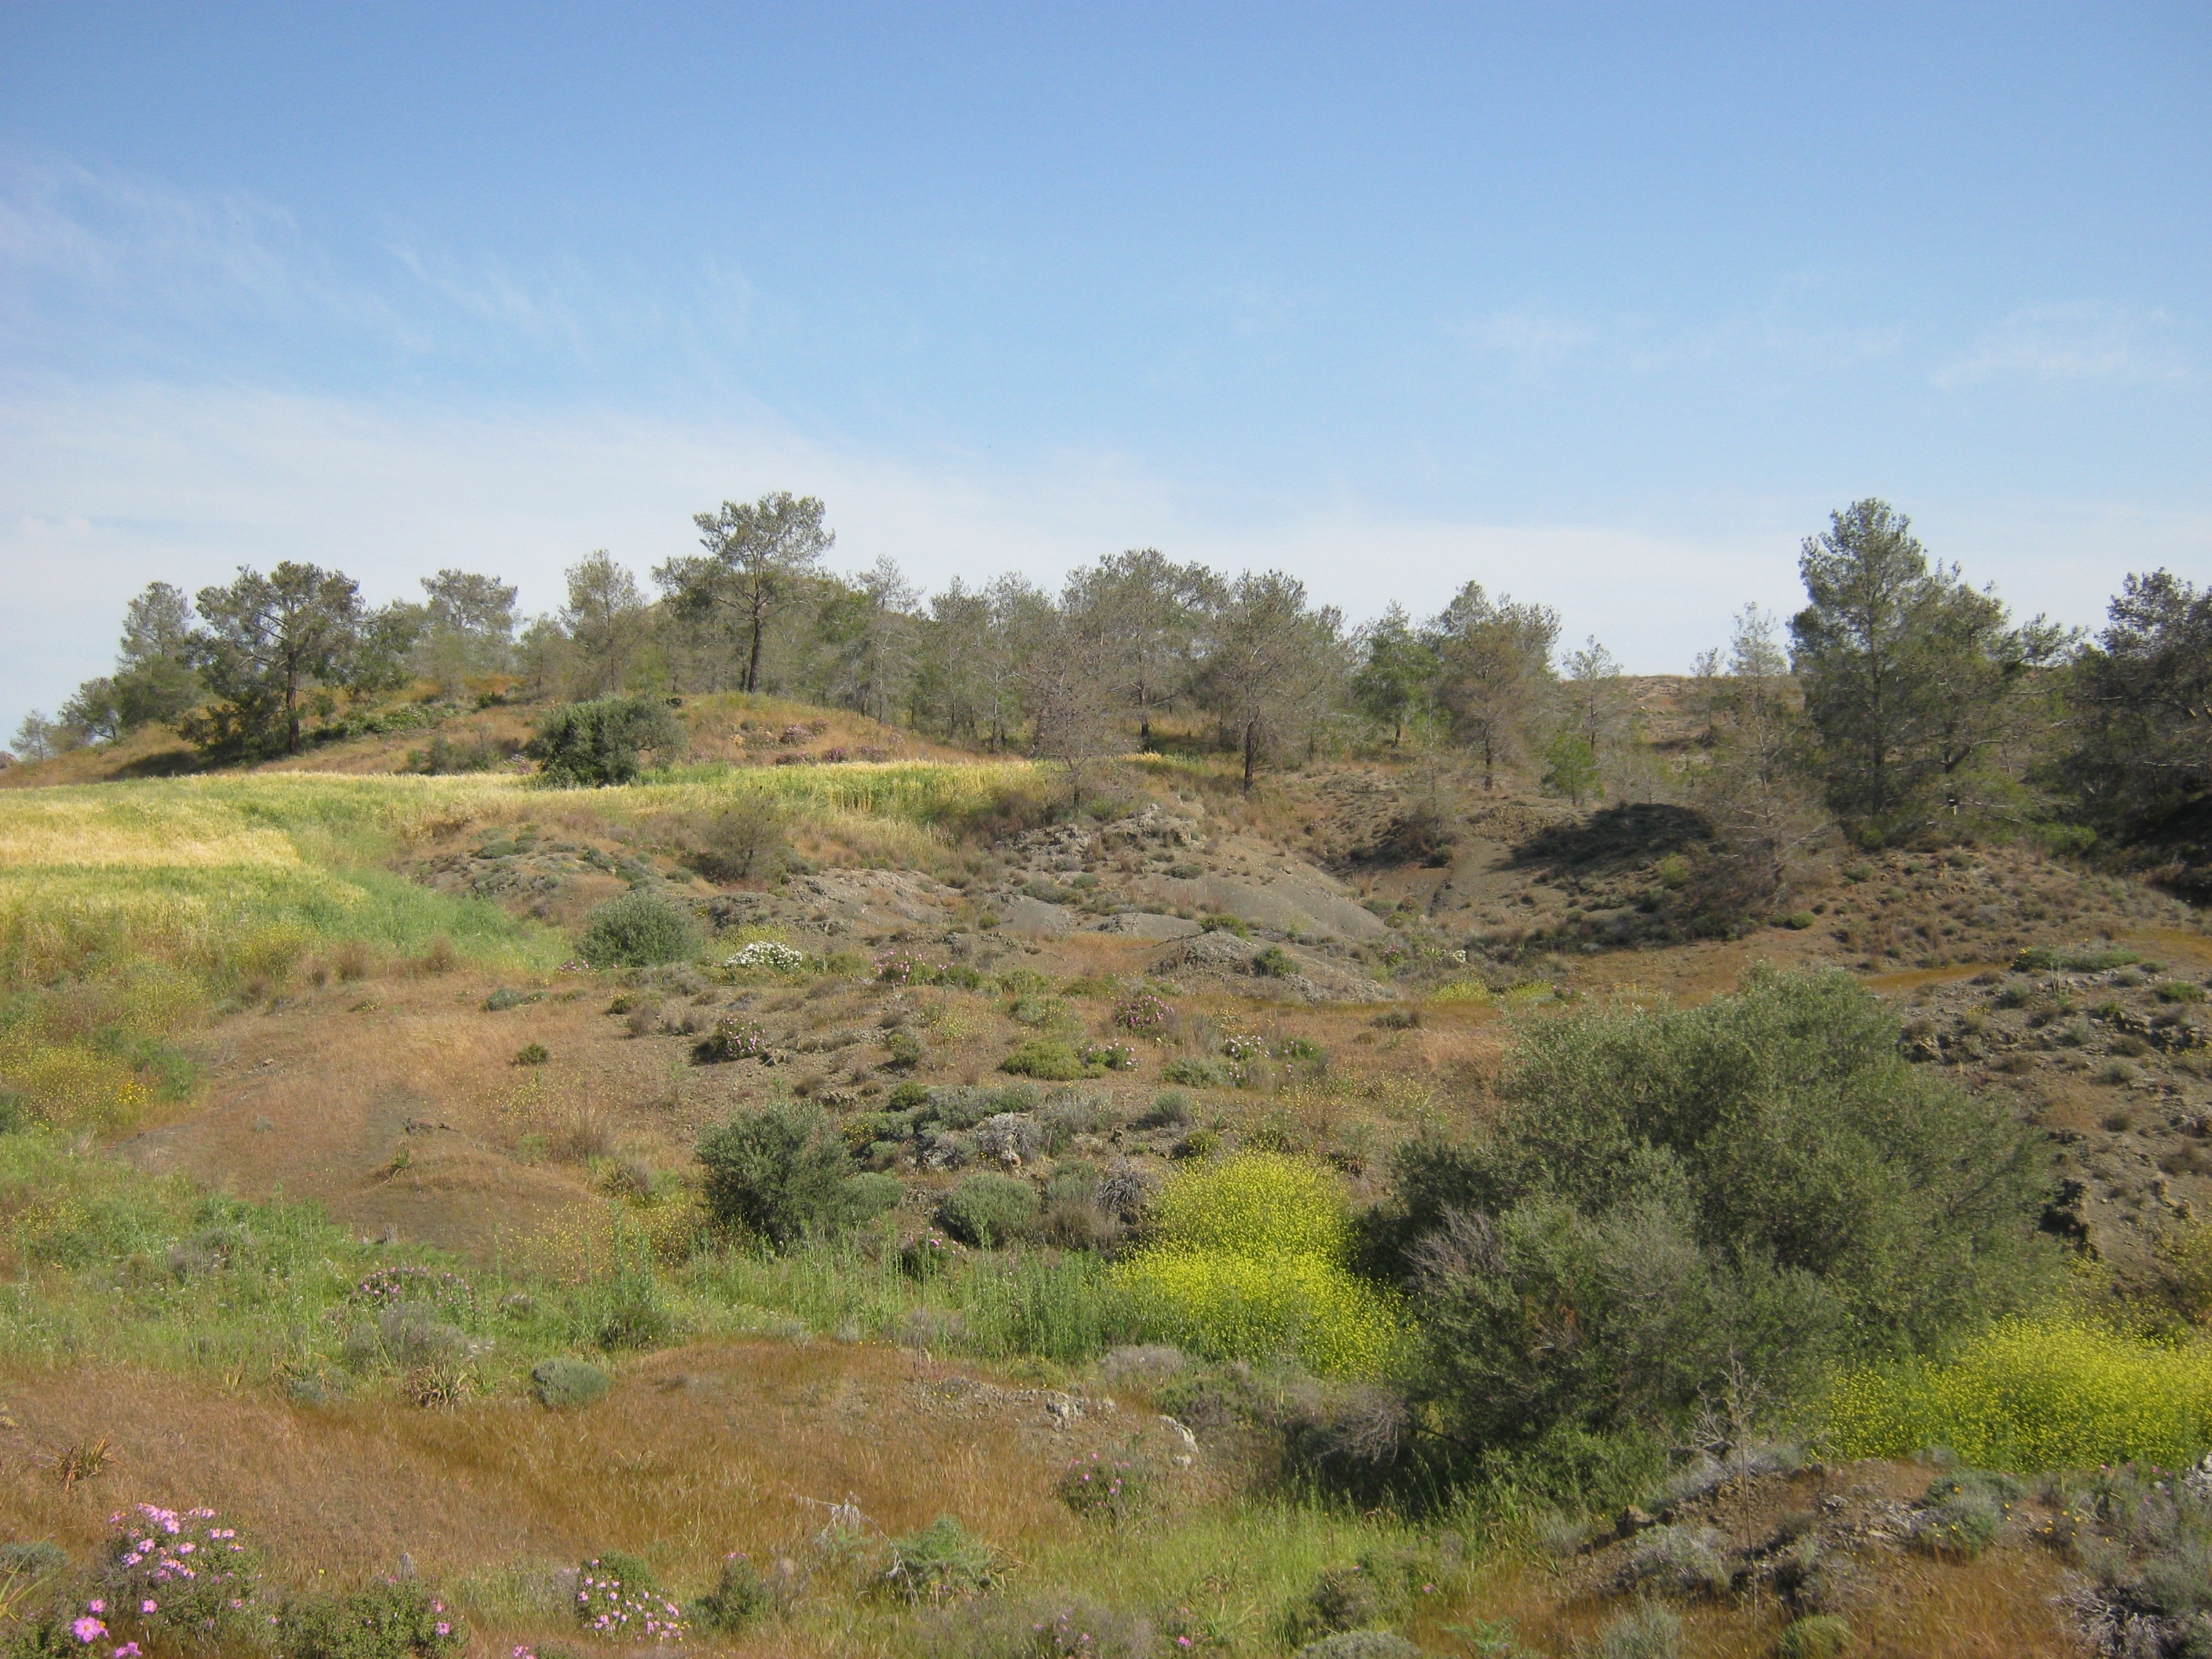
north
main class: Shrubland
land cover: Shrubland with sparse tree cover
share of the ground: 25 - 50 %
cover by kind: herbaceous plants 50 %, shrubs 45 %, broadleaved forest trees 5 %
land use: Semi-natural and natural areas not in use
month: April
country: CY
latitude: 34.9608
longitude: 33.3718
